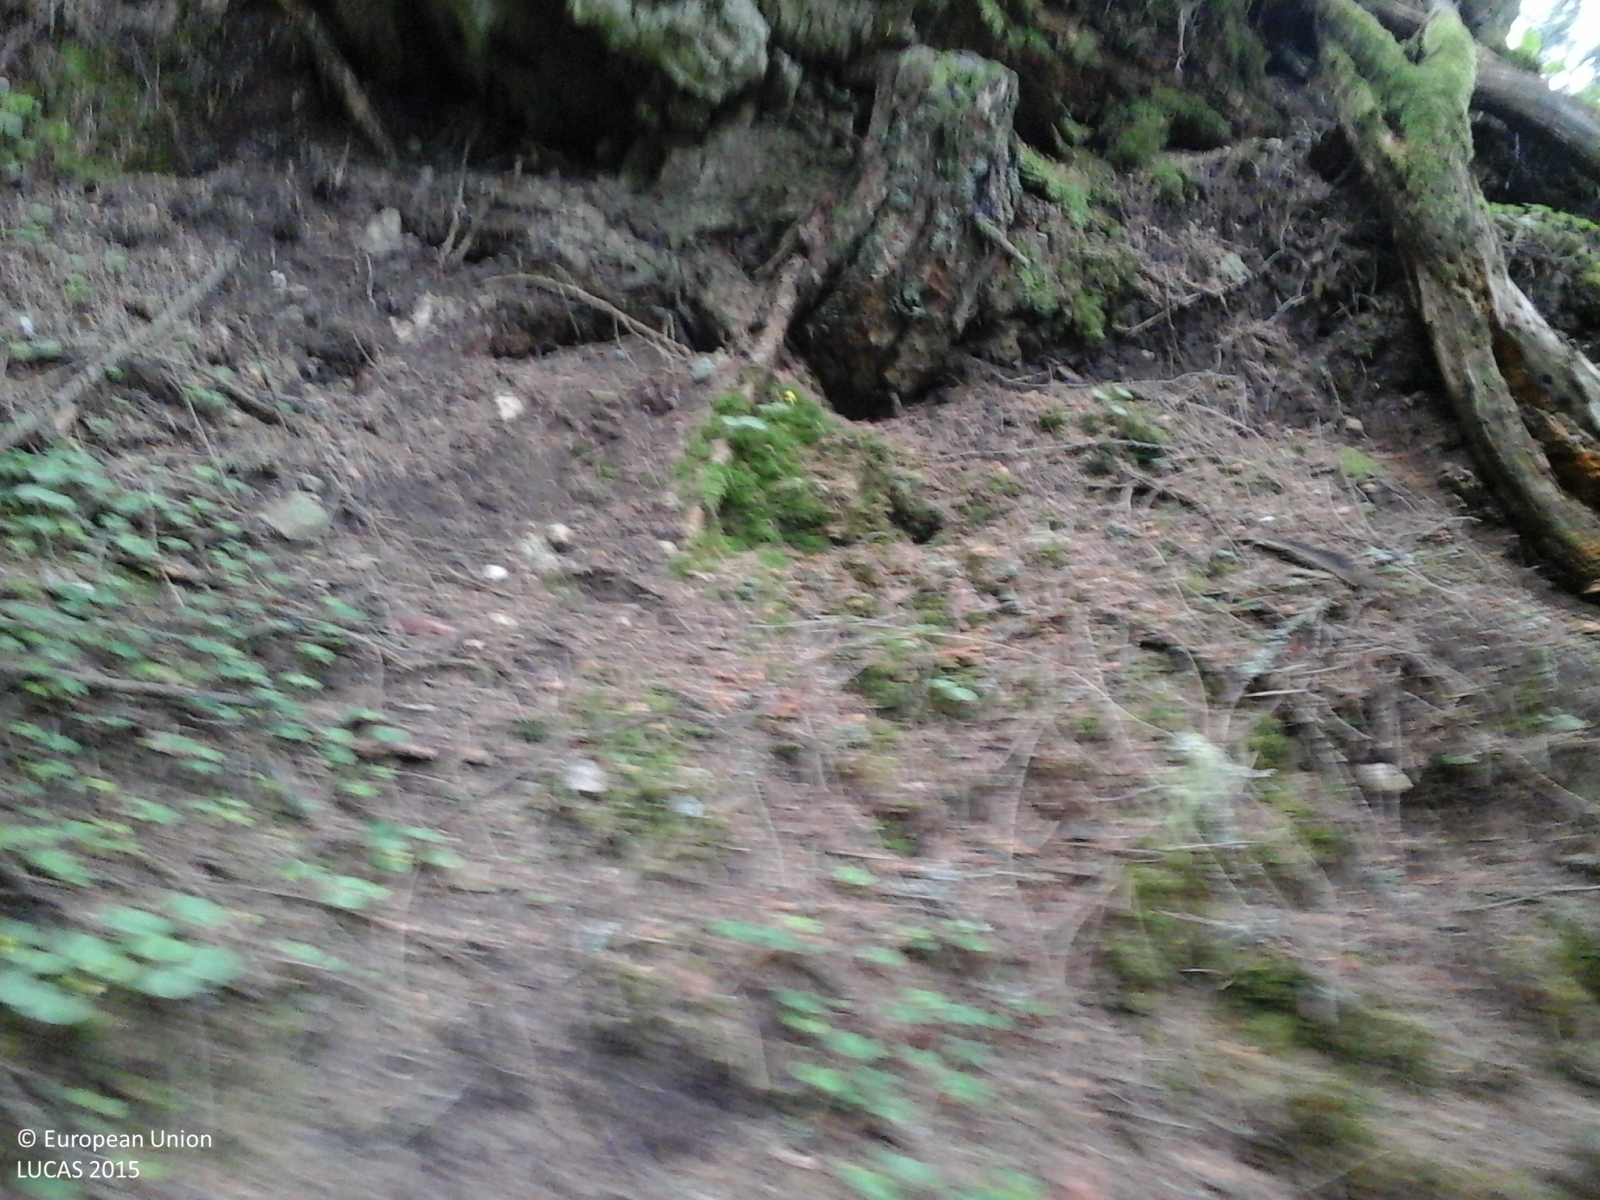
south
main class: Woodland
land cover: Spruce dominated coniferous woodland
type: alpine coniferous forest
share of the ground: > 75 %
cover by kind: coniferous forest trees 100 %
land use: Forestry
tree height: > 5 m
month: June
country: IT
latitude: 46.5374
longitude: 11.6019
